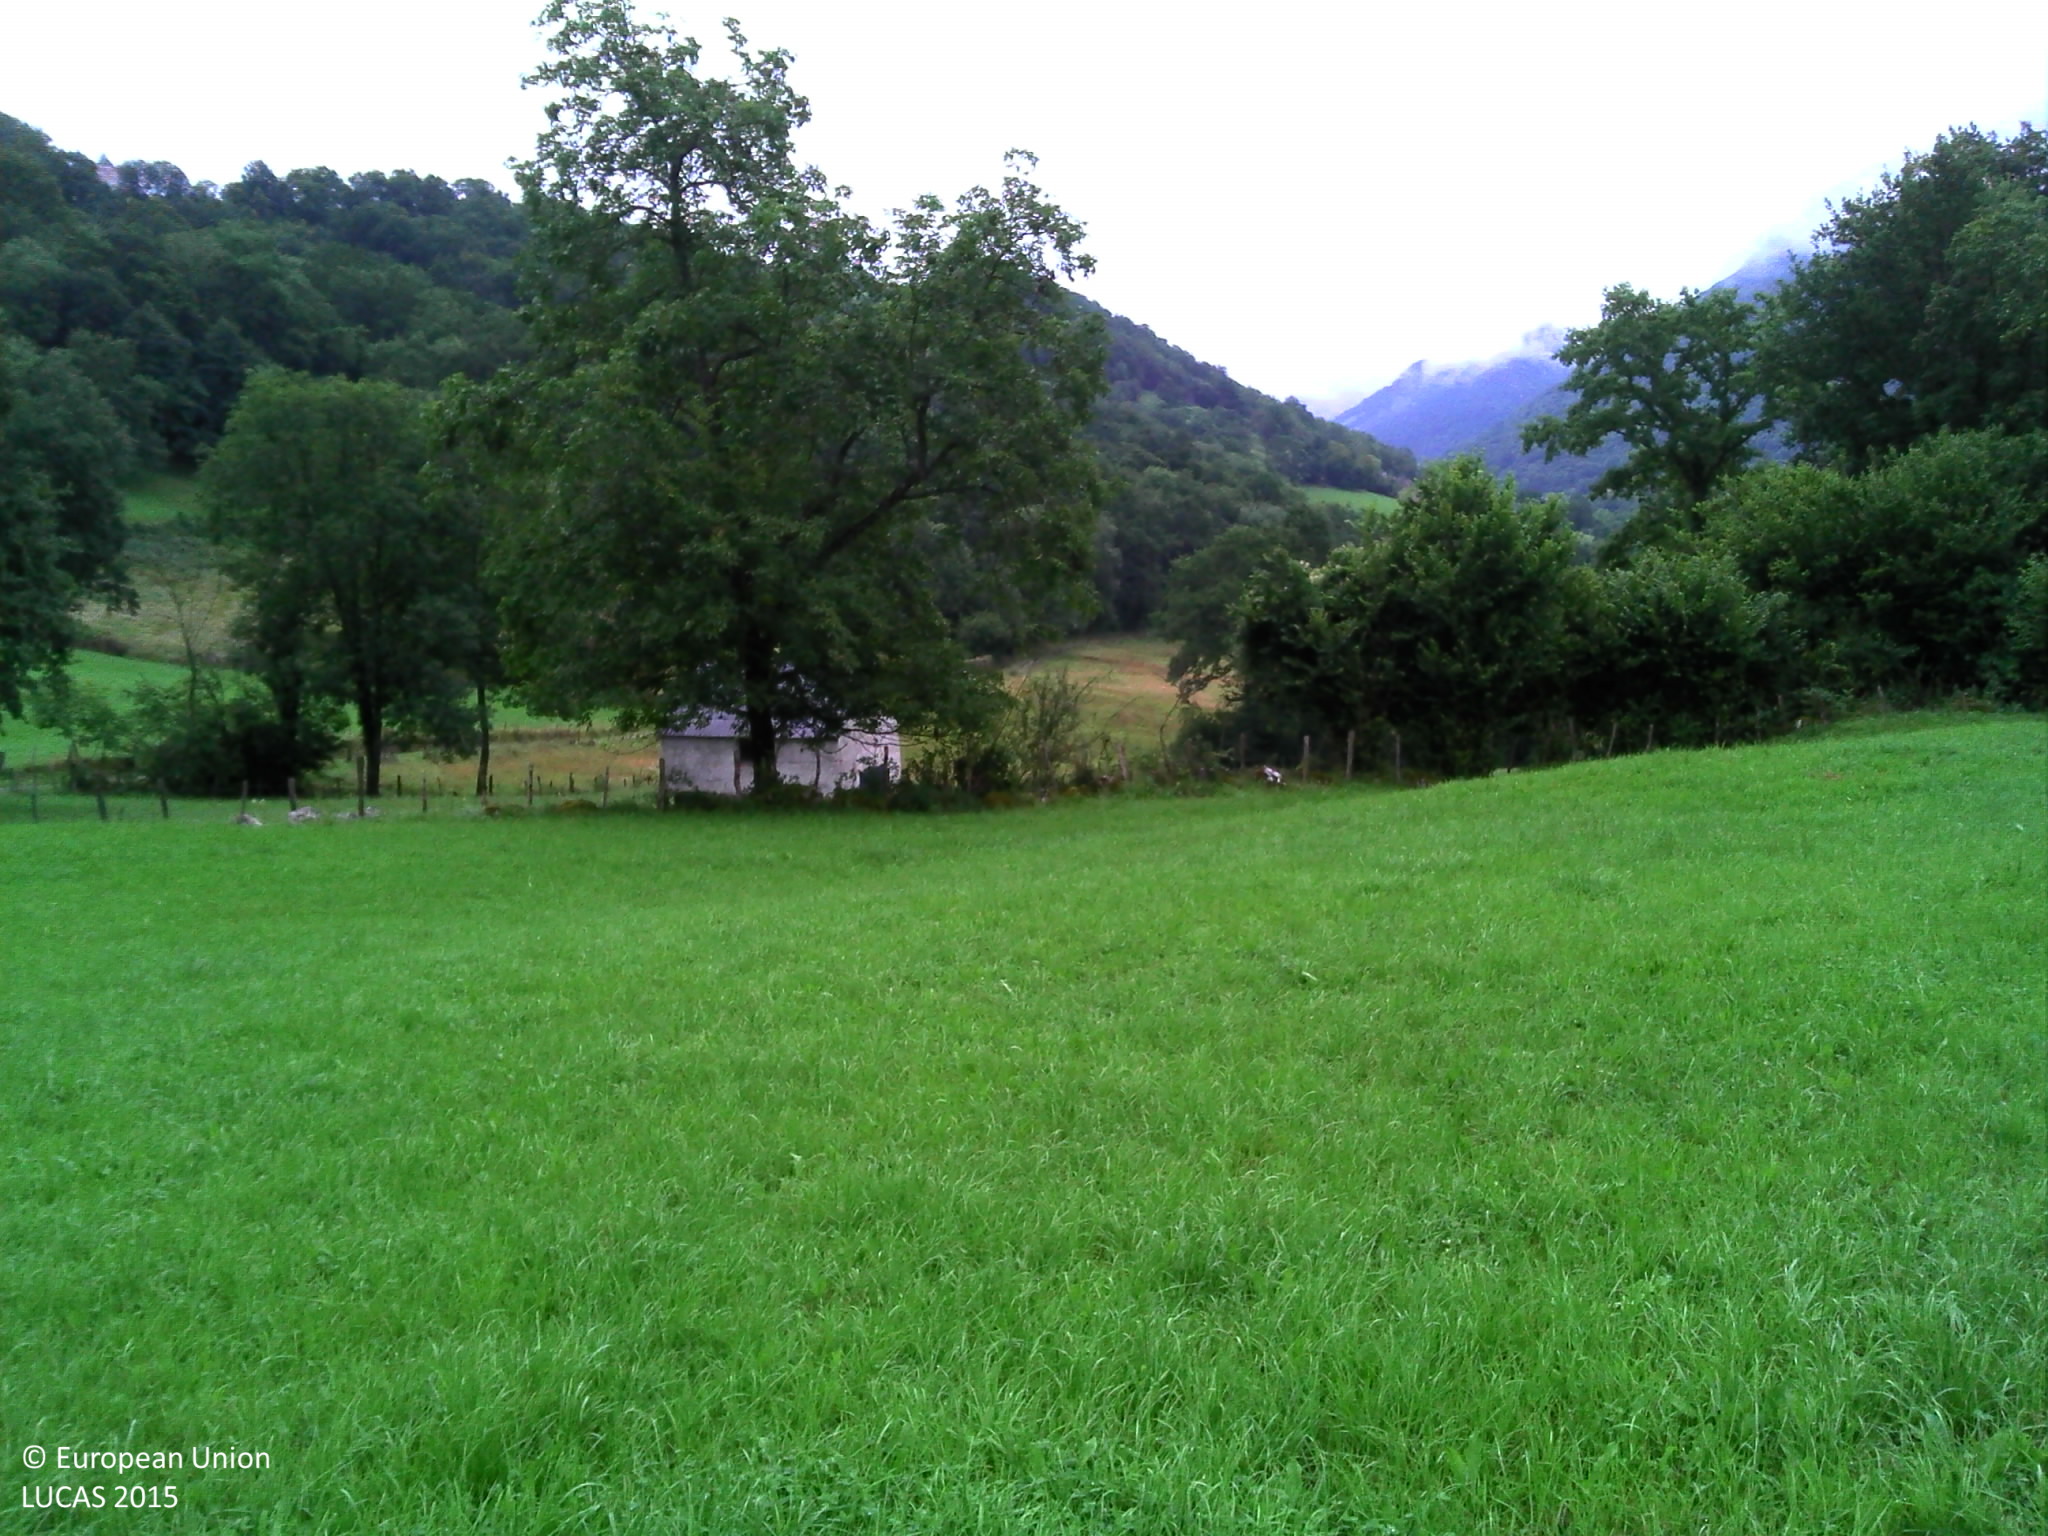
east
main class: Grassland
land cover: Grassland without tree/shrub cover
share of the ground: > 75 %
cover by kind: herbaceous plants 100 %
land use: Agriculture (excluding fallow land and kitchen gardens)
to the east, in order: Grassland without tree/shrub cover; Dry stone walls; Fences; Managed hedges; Grassland without tree/shrub cover; Tracks; Grassland without tree/shrub cover; Fences; Dry stone walls; Rivers and streams; Shruby margins; Grassland without tree/shrub cover
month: July
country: FR
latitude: 43.1007
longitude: -0.3879
